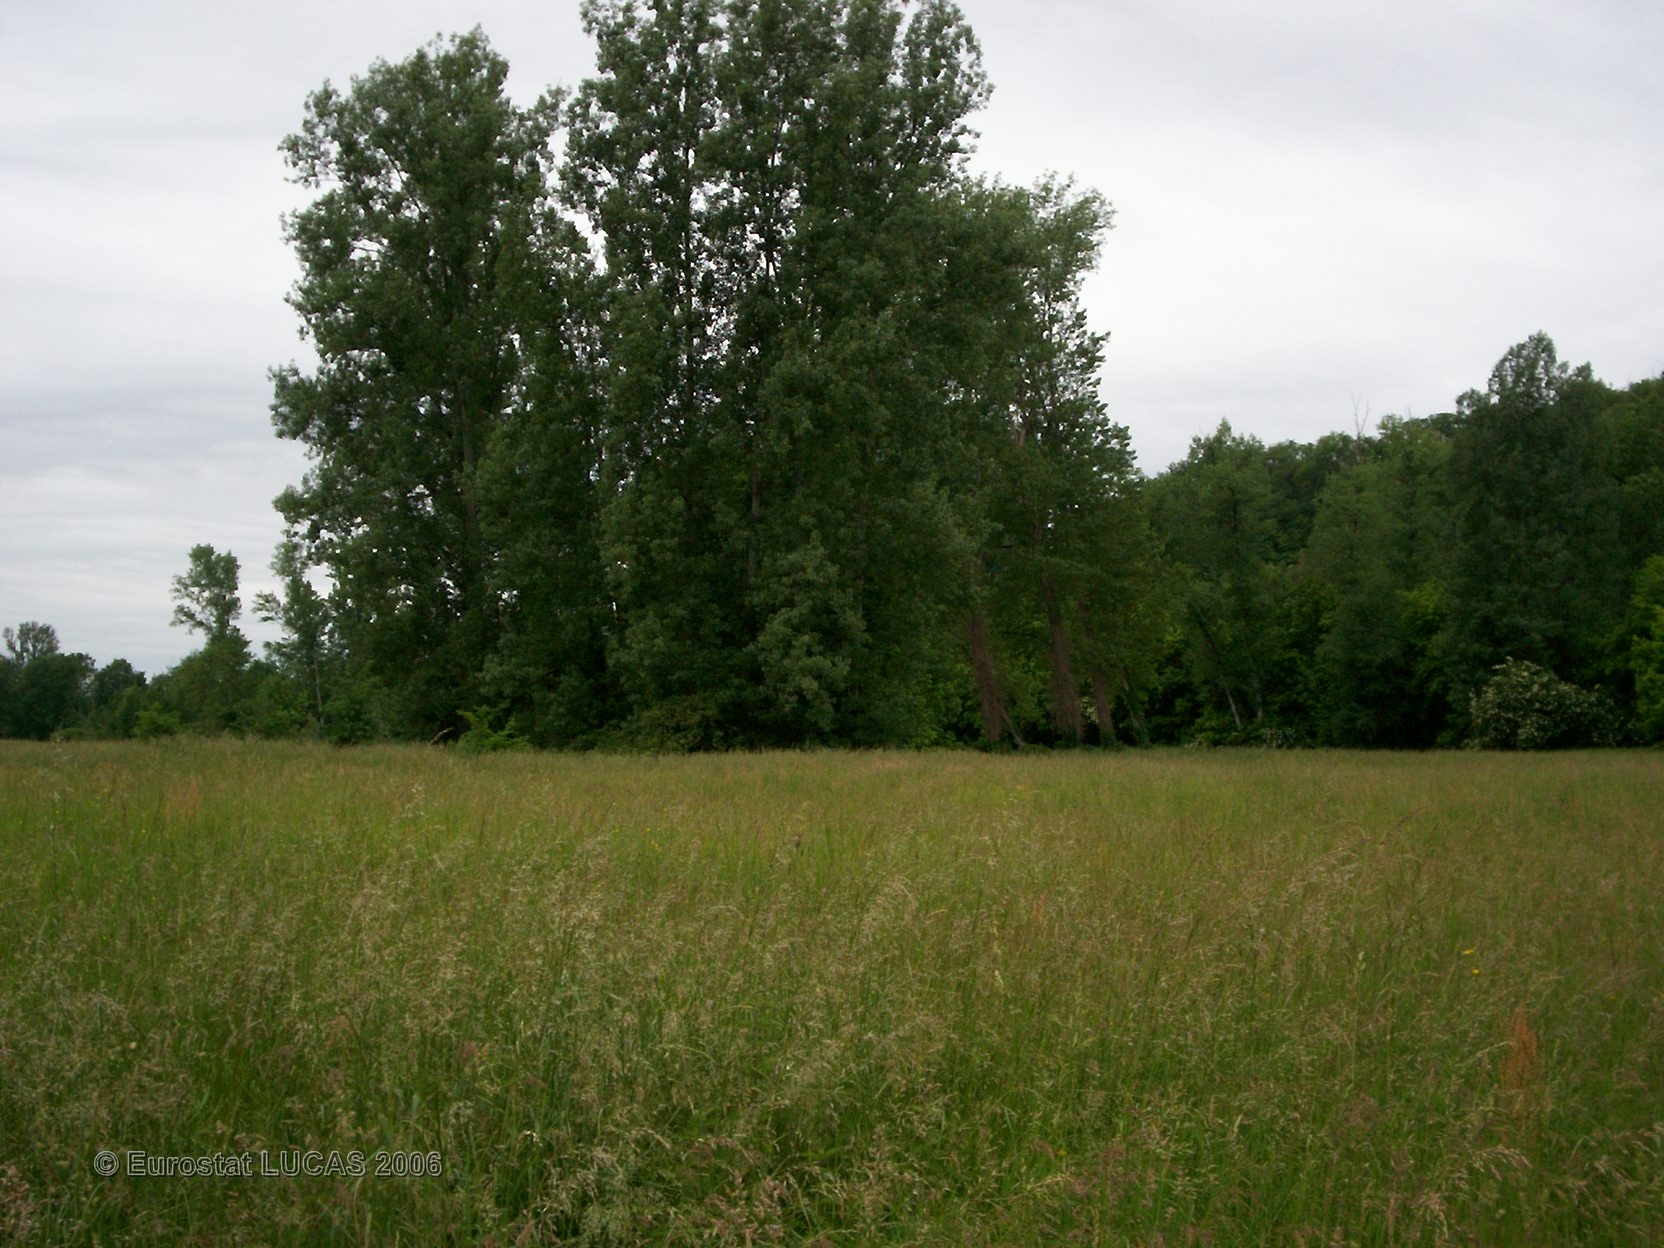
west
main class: Grassland
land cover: Grassland without tree/shrub cover
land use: Agriculture (excluding fallow land and kitchen gardens)
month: May
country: FR
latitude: 44.8591
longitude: 1.3524
